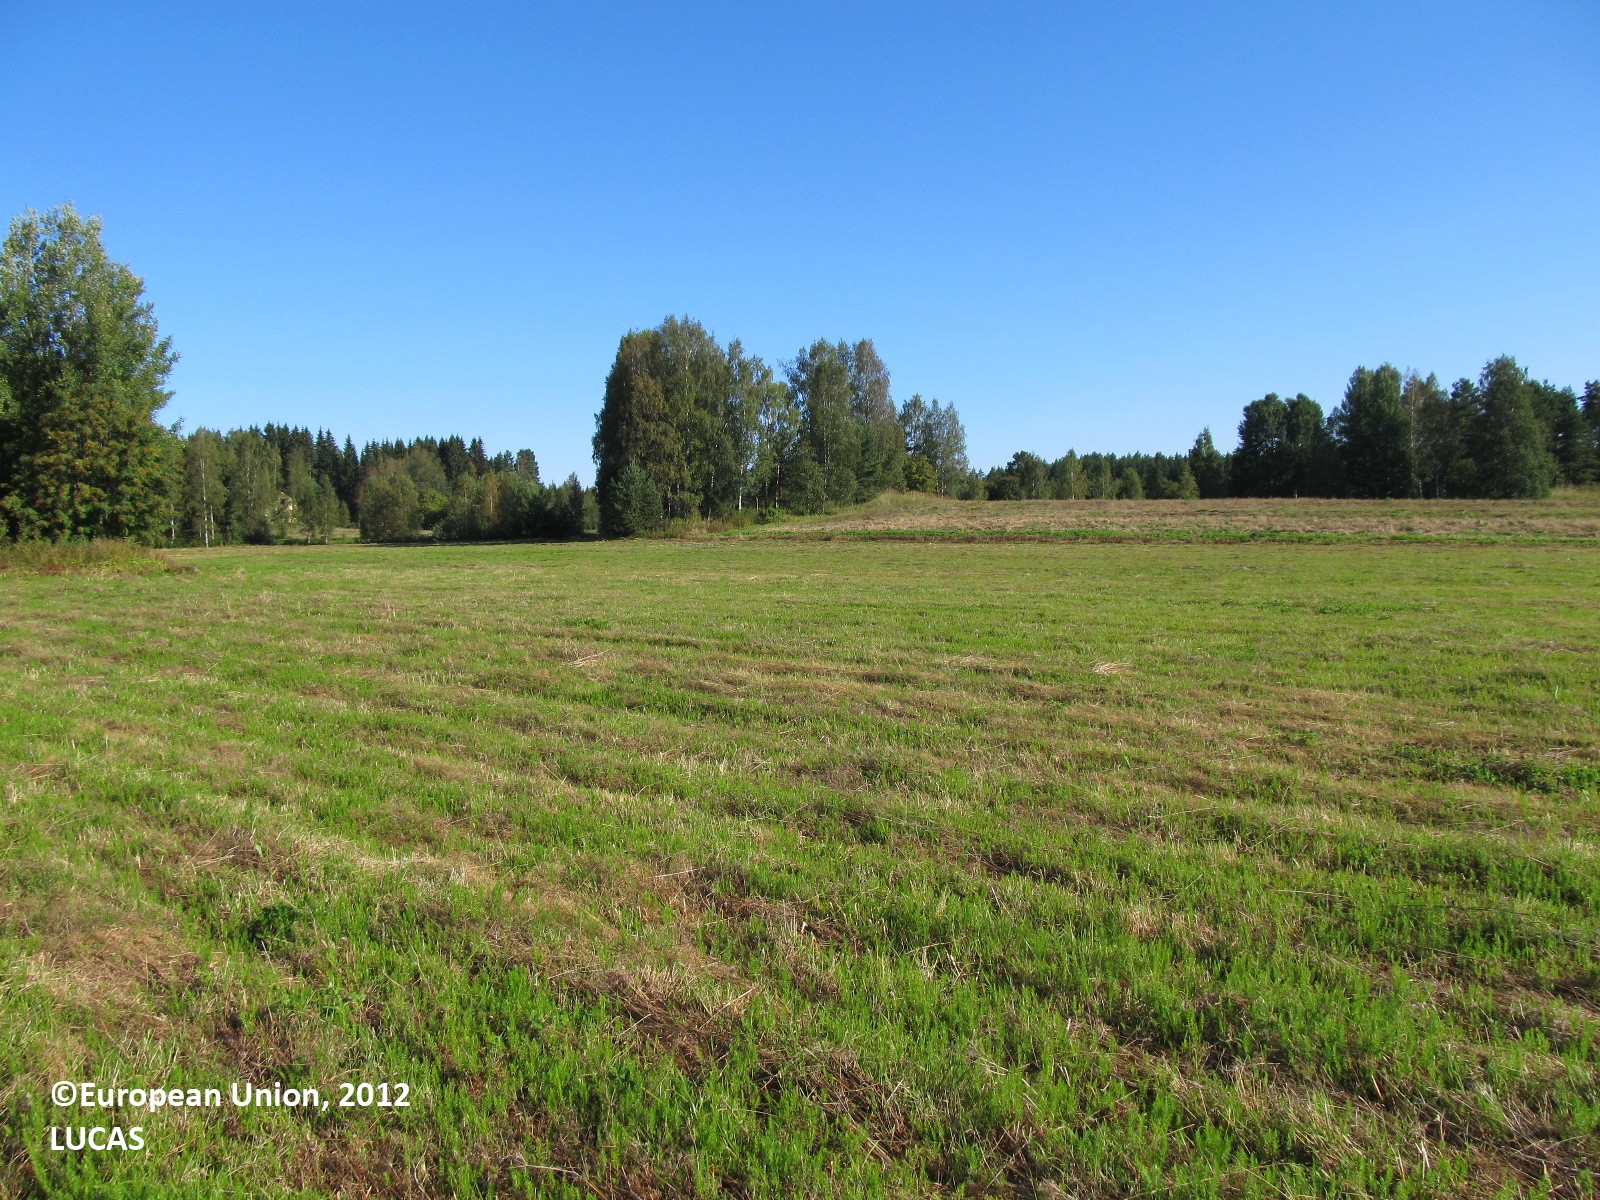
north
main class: Cropland
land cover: Temporary grasslands
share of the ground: 50 - 75 %
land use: Agriculture (excluding fallow land and kitchen gardens)
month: August
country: FI
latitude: 61.8325
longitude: 27.5122
